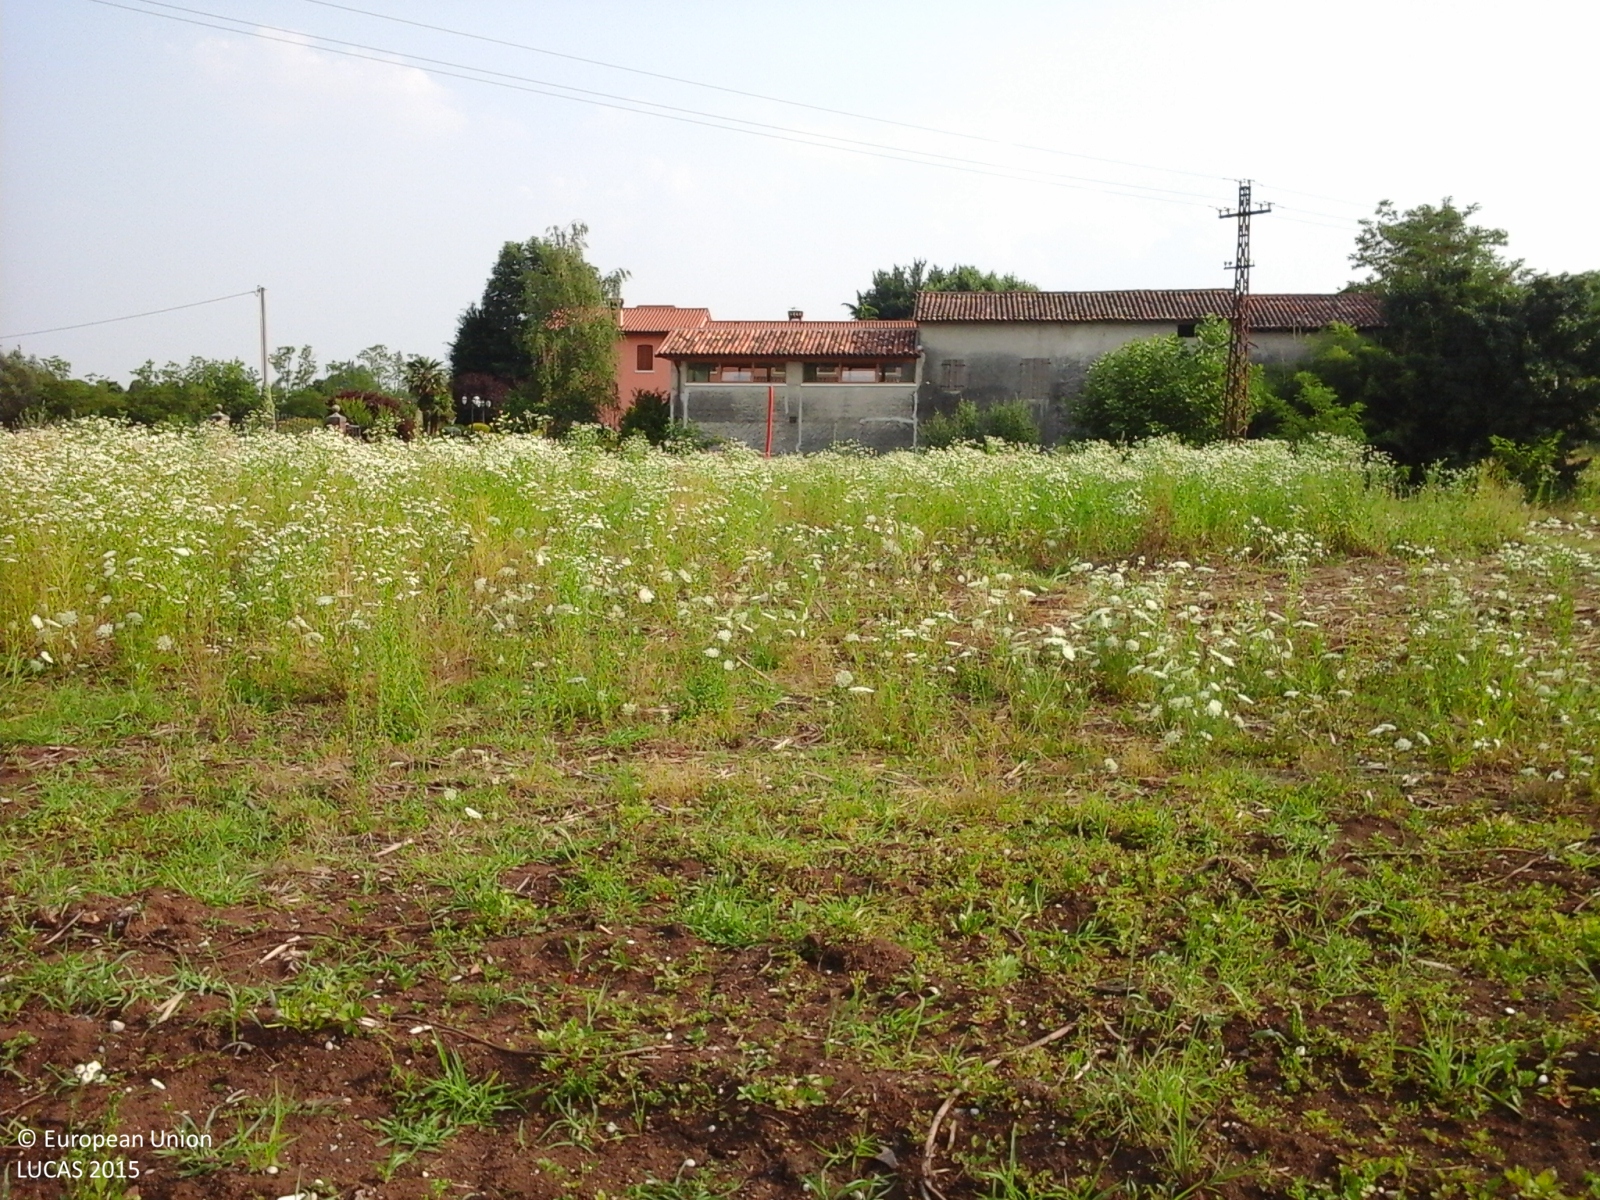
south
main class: Grassland
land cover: Spontaneously vegetated surfaces
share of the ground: 25 - 50 %
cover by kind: consolidated bare surface 60 %, herbaceous plants 40 %
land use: Fallow land
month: June
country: IT
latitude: 45.7261
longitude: 11.6294
